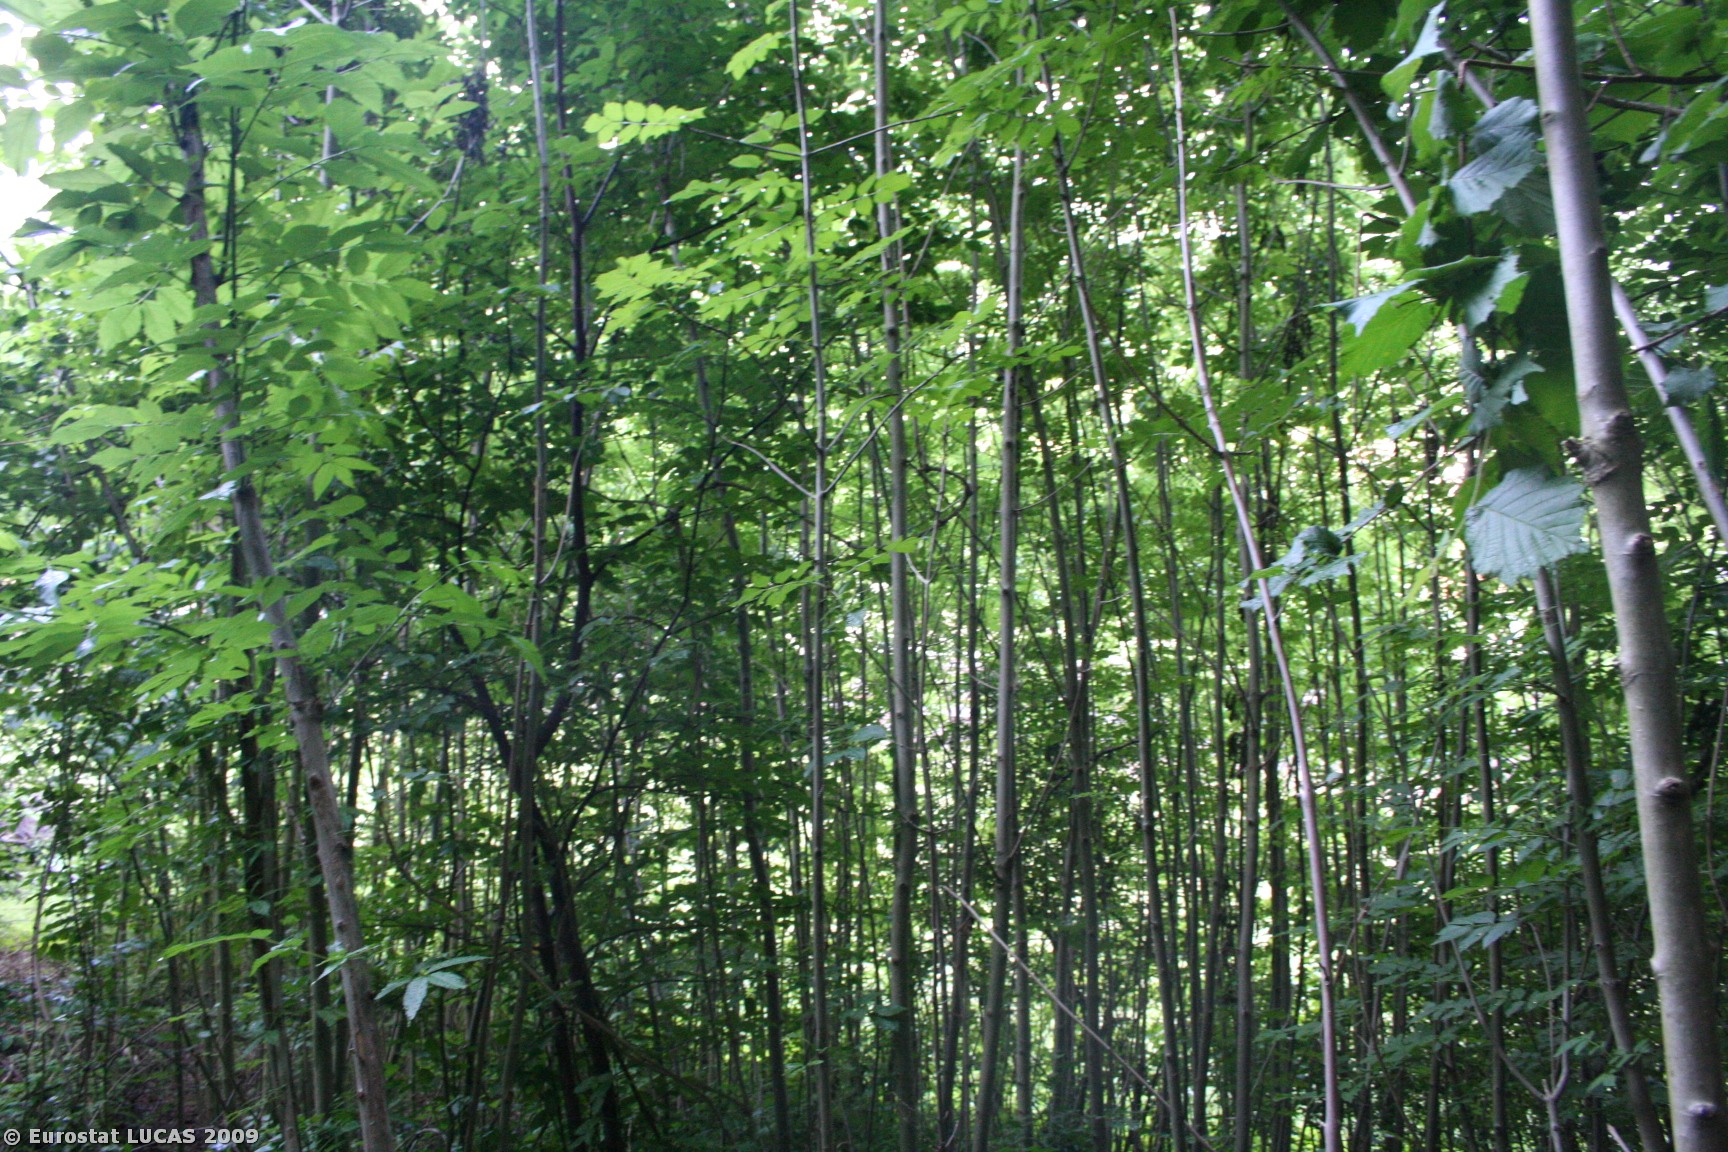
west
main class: Woodland
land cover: Broadleaved woodland
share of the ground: > 75 %
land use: Forestry
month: June
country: AT
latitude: 47.4748
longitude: 13.1961
